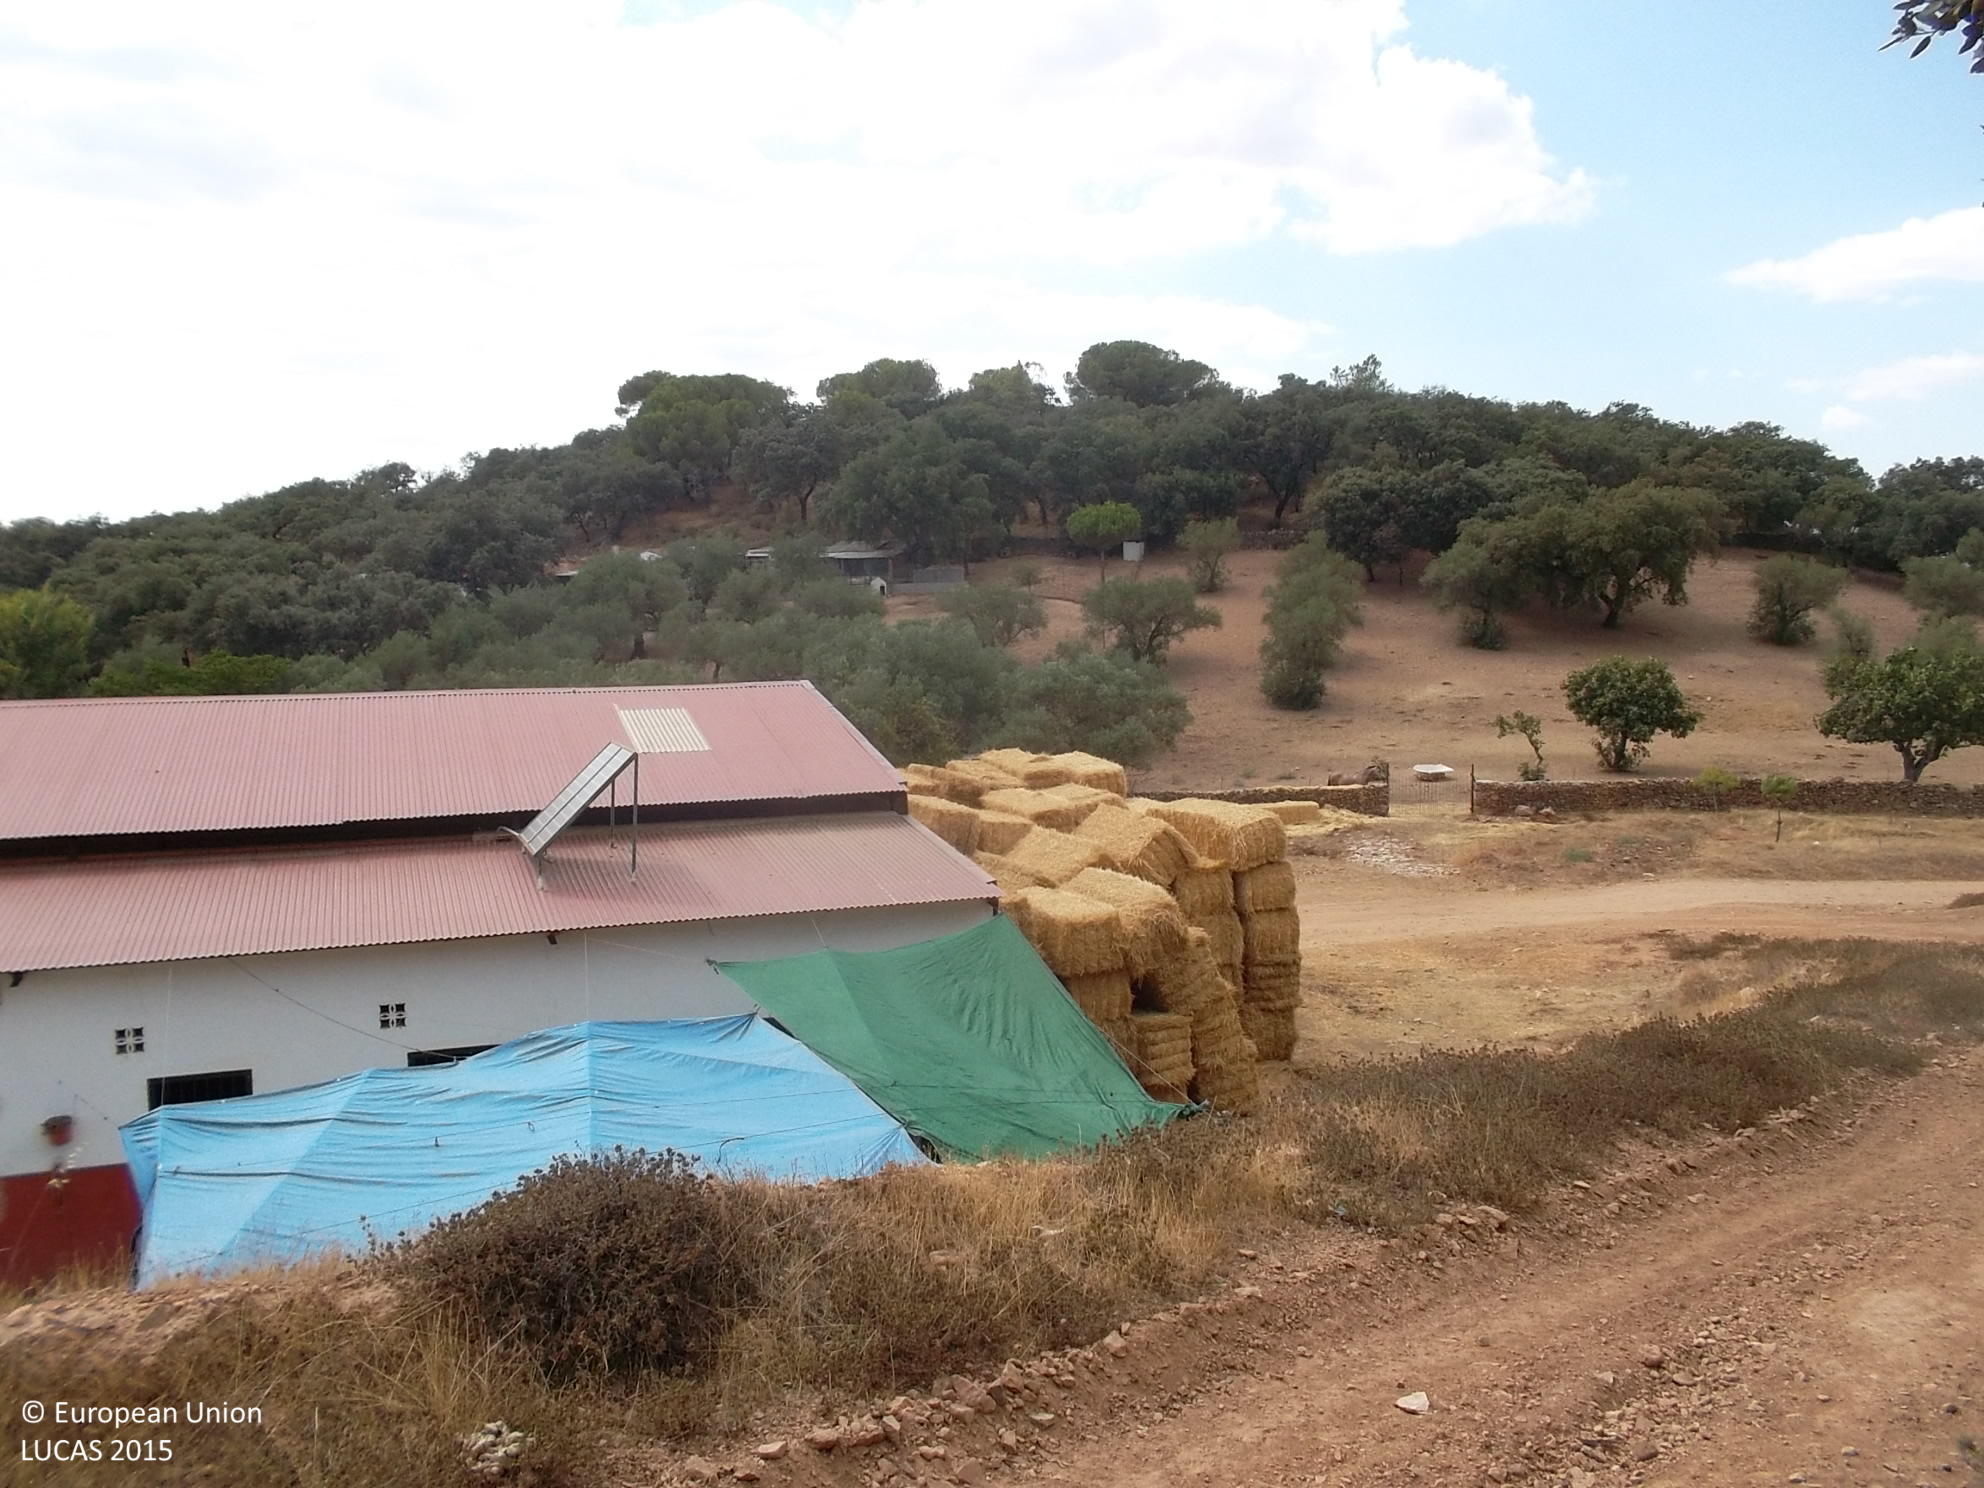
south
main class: Woodland
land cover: Broadleaved woodland
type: broadleaved evergreen forest
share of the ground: > 75 %
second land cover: Grassland without tree/shrub cover
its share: > 75 %
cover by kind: broadleaved forest trees 80 %, herbaceous plants 20 %
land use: Forestry
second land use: Agriculture (excluding fallow land and kitchen gardens)
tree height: > 5 m
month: September
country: ES
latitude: 38.0778
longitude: -6.5423
